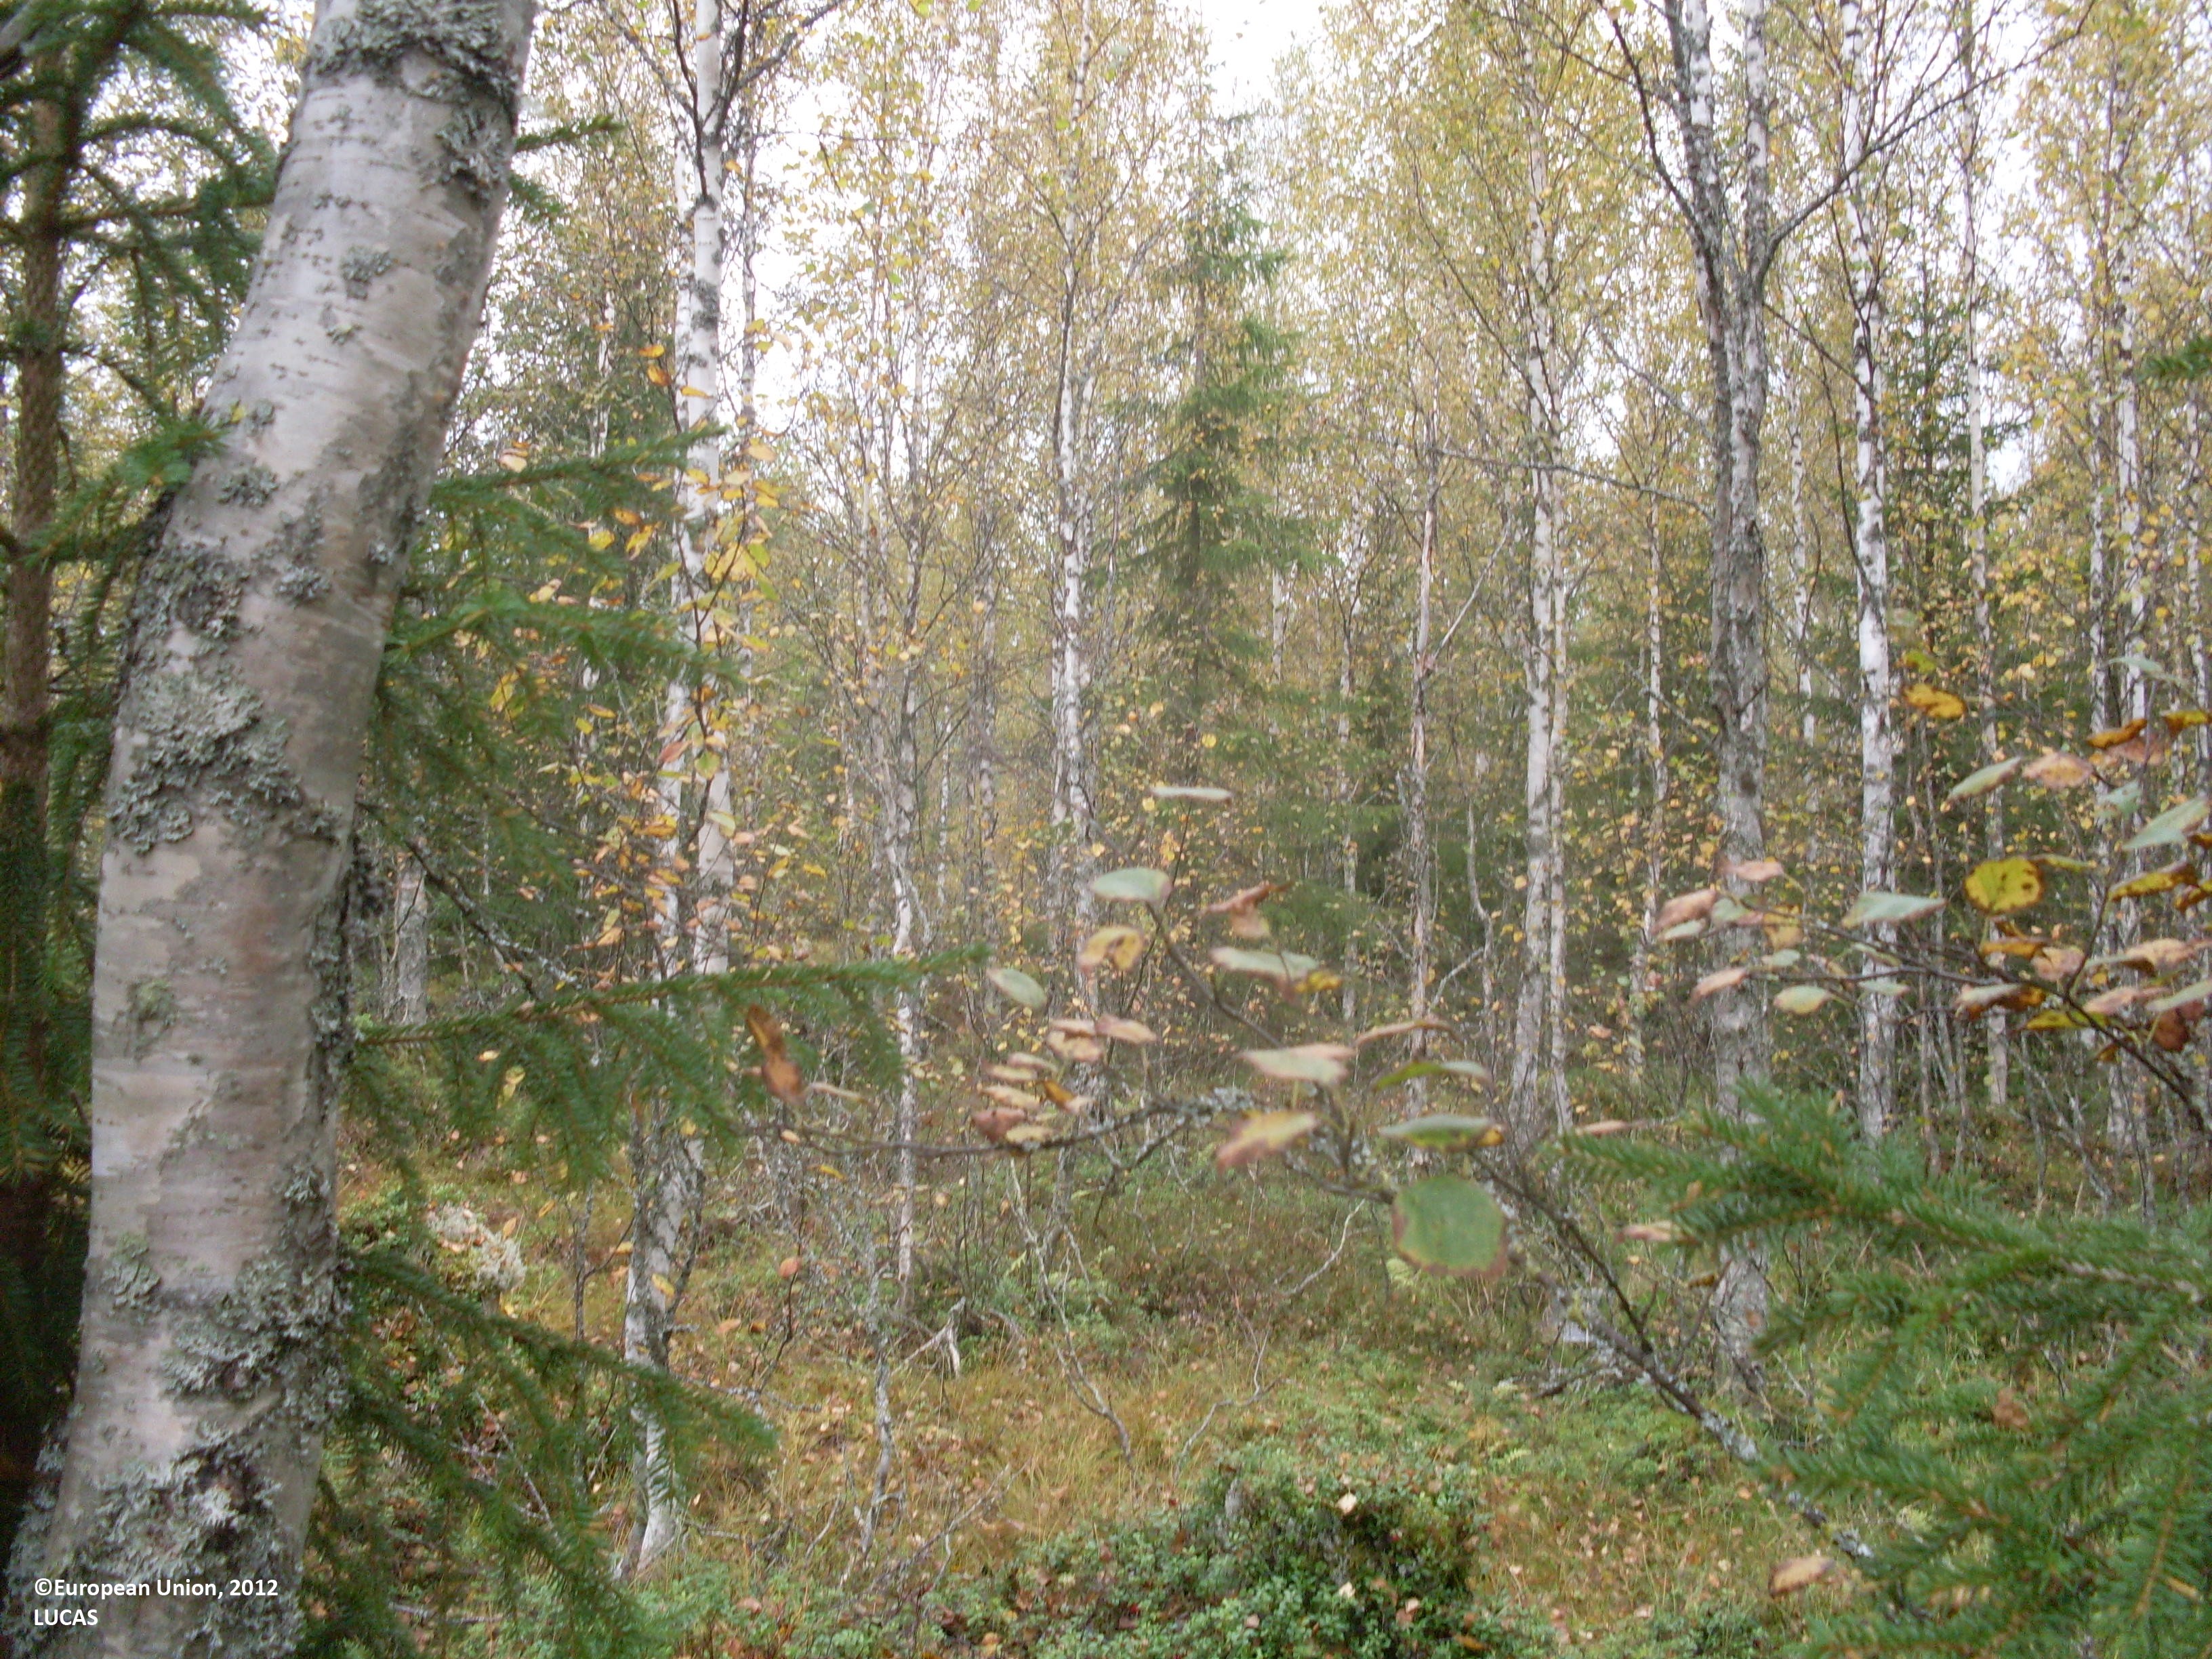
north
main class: Woodland
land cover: Other mixed woodland
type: boreal forest
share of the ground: > 75 %
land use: Forestry
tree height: > 5 m
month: September
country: FI
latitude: 63.9928
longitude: 29.4959
